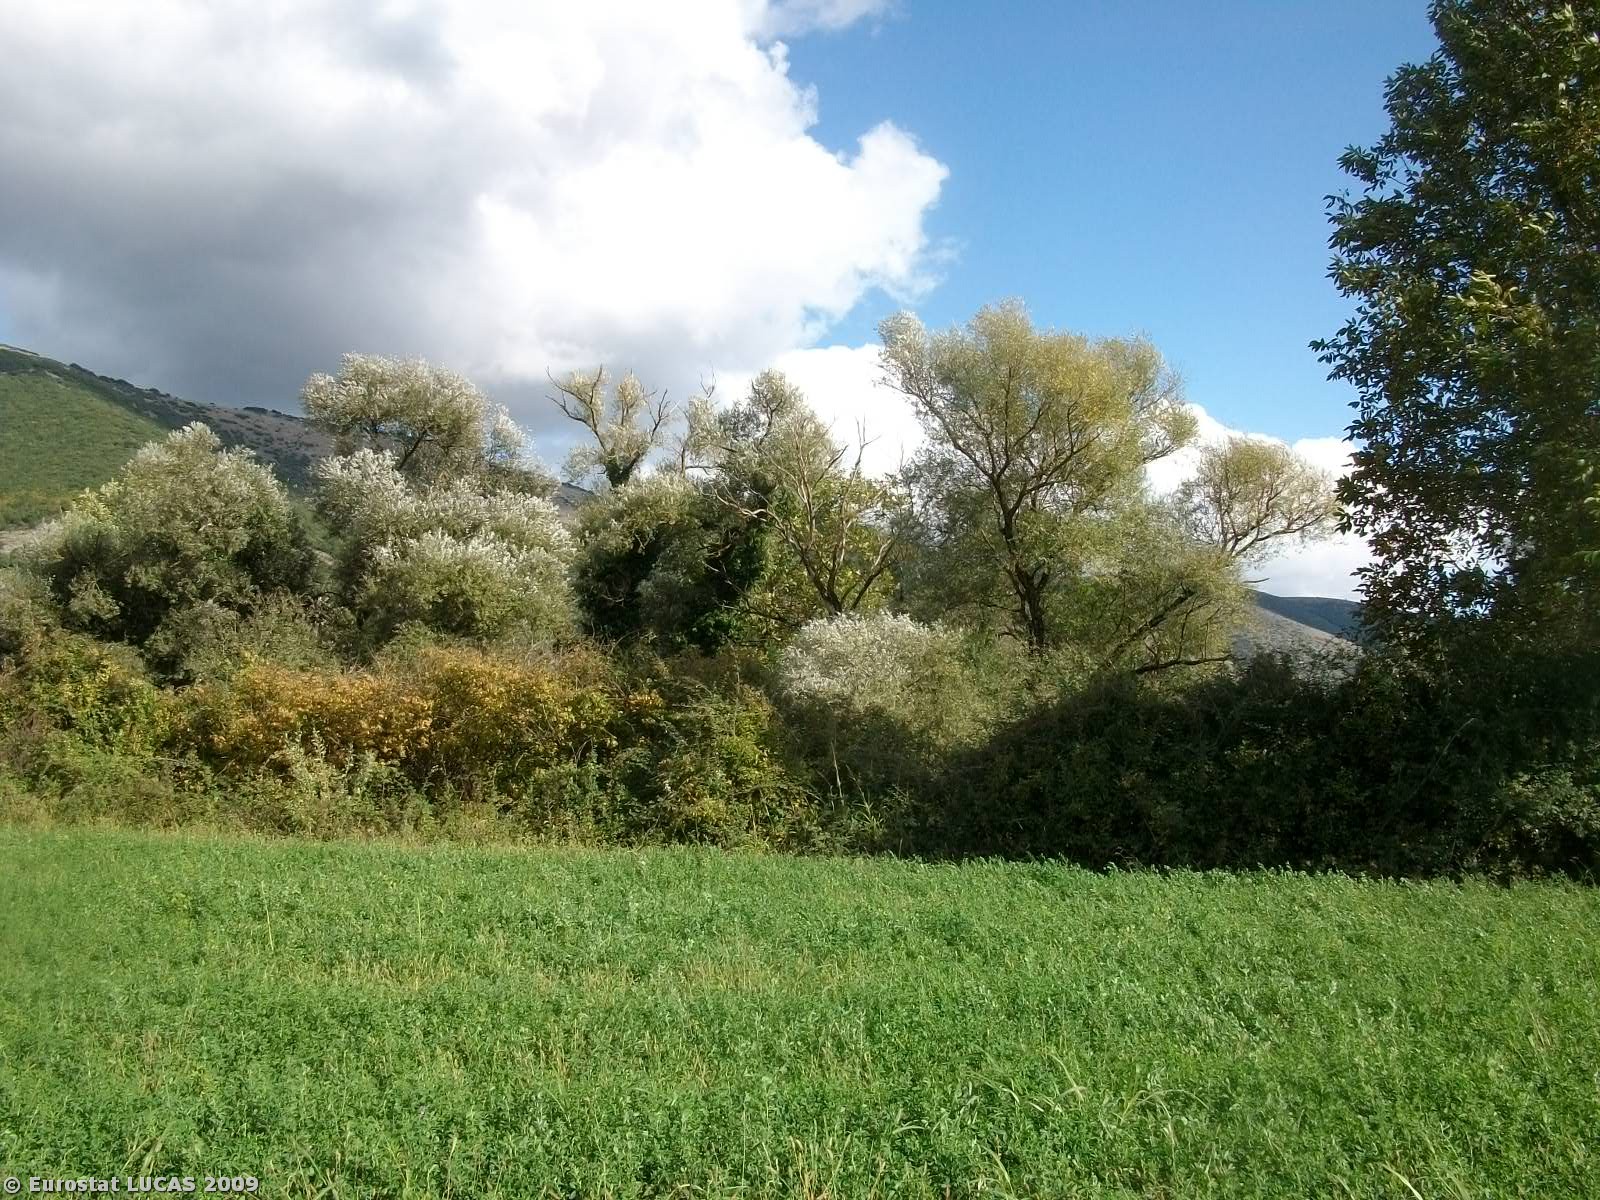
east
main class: Cropland
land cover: Clovers
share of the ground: > 75 %
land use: Agriculture (excluding fallow land and kitchen gardens)
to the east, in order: Clovers; Grass margins; Ditches and canals; Shrubland without tree cover; Paved roads, cycling and walking lanes; Grassland without tree/shrub cover; Abandoned hedges; Inland running water; Broadleaved woodland; Grass margins; Clovers; Grass margins; Ditches and canals; Grass margins; Paved roads, cycling and walking lanes; Grassland without tree/shrub cover; Fences; Grassland without tree/shrub cover
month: October
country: GR
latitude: 39.8193
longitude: 20.5981
